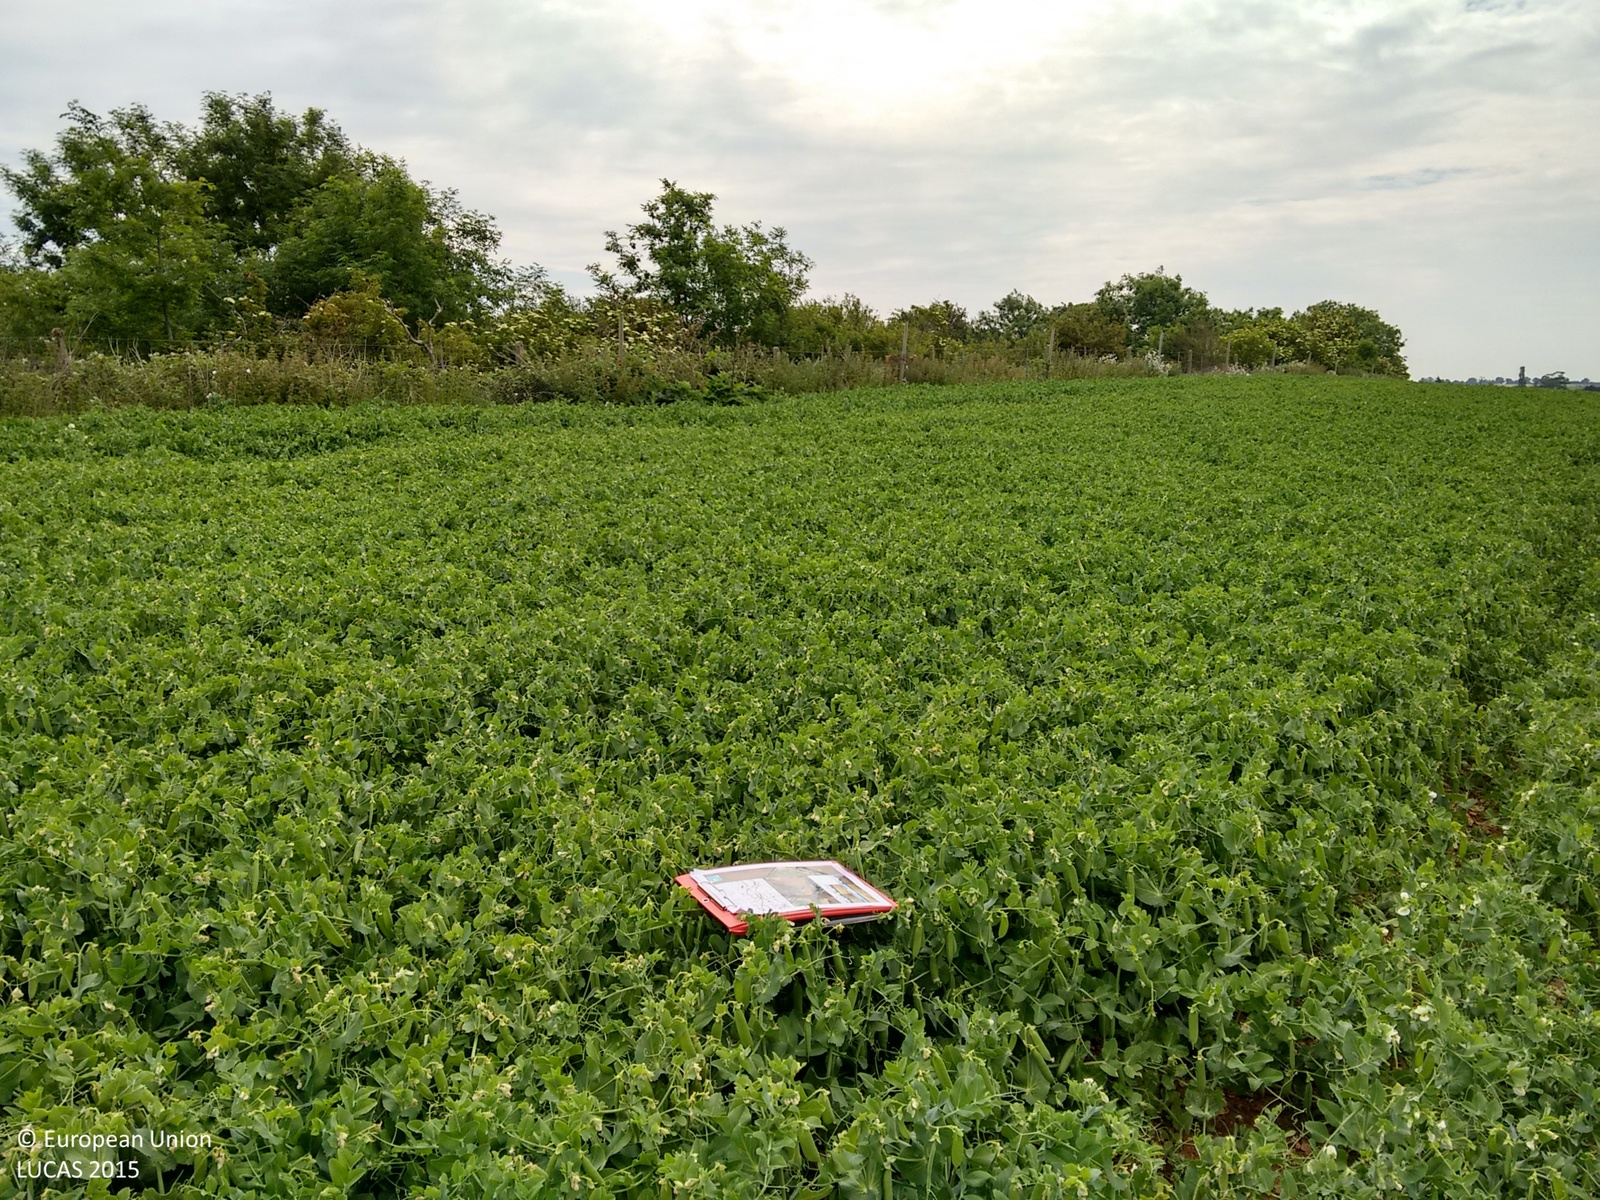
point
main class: Cropland
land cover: Dry pulses
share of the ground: > 75 %
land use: Agriculture (excluding fallow land and kitchen gardens)
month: June
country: GB
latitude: 52.9797
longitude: -0.5080
